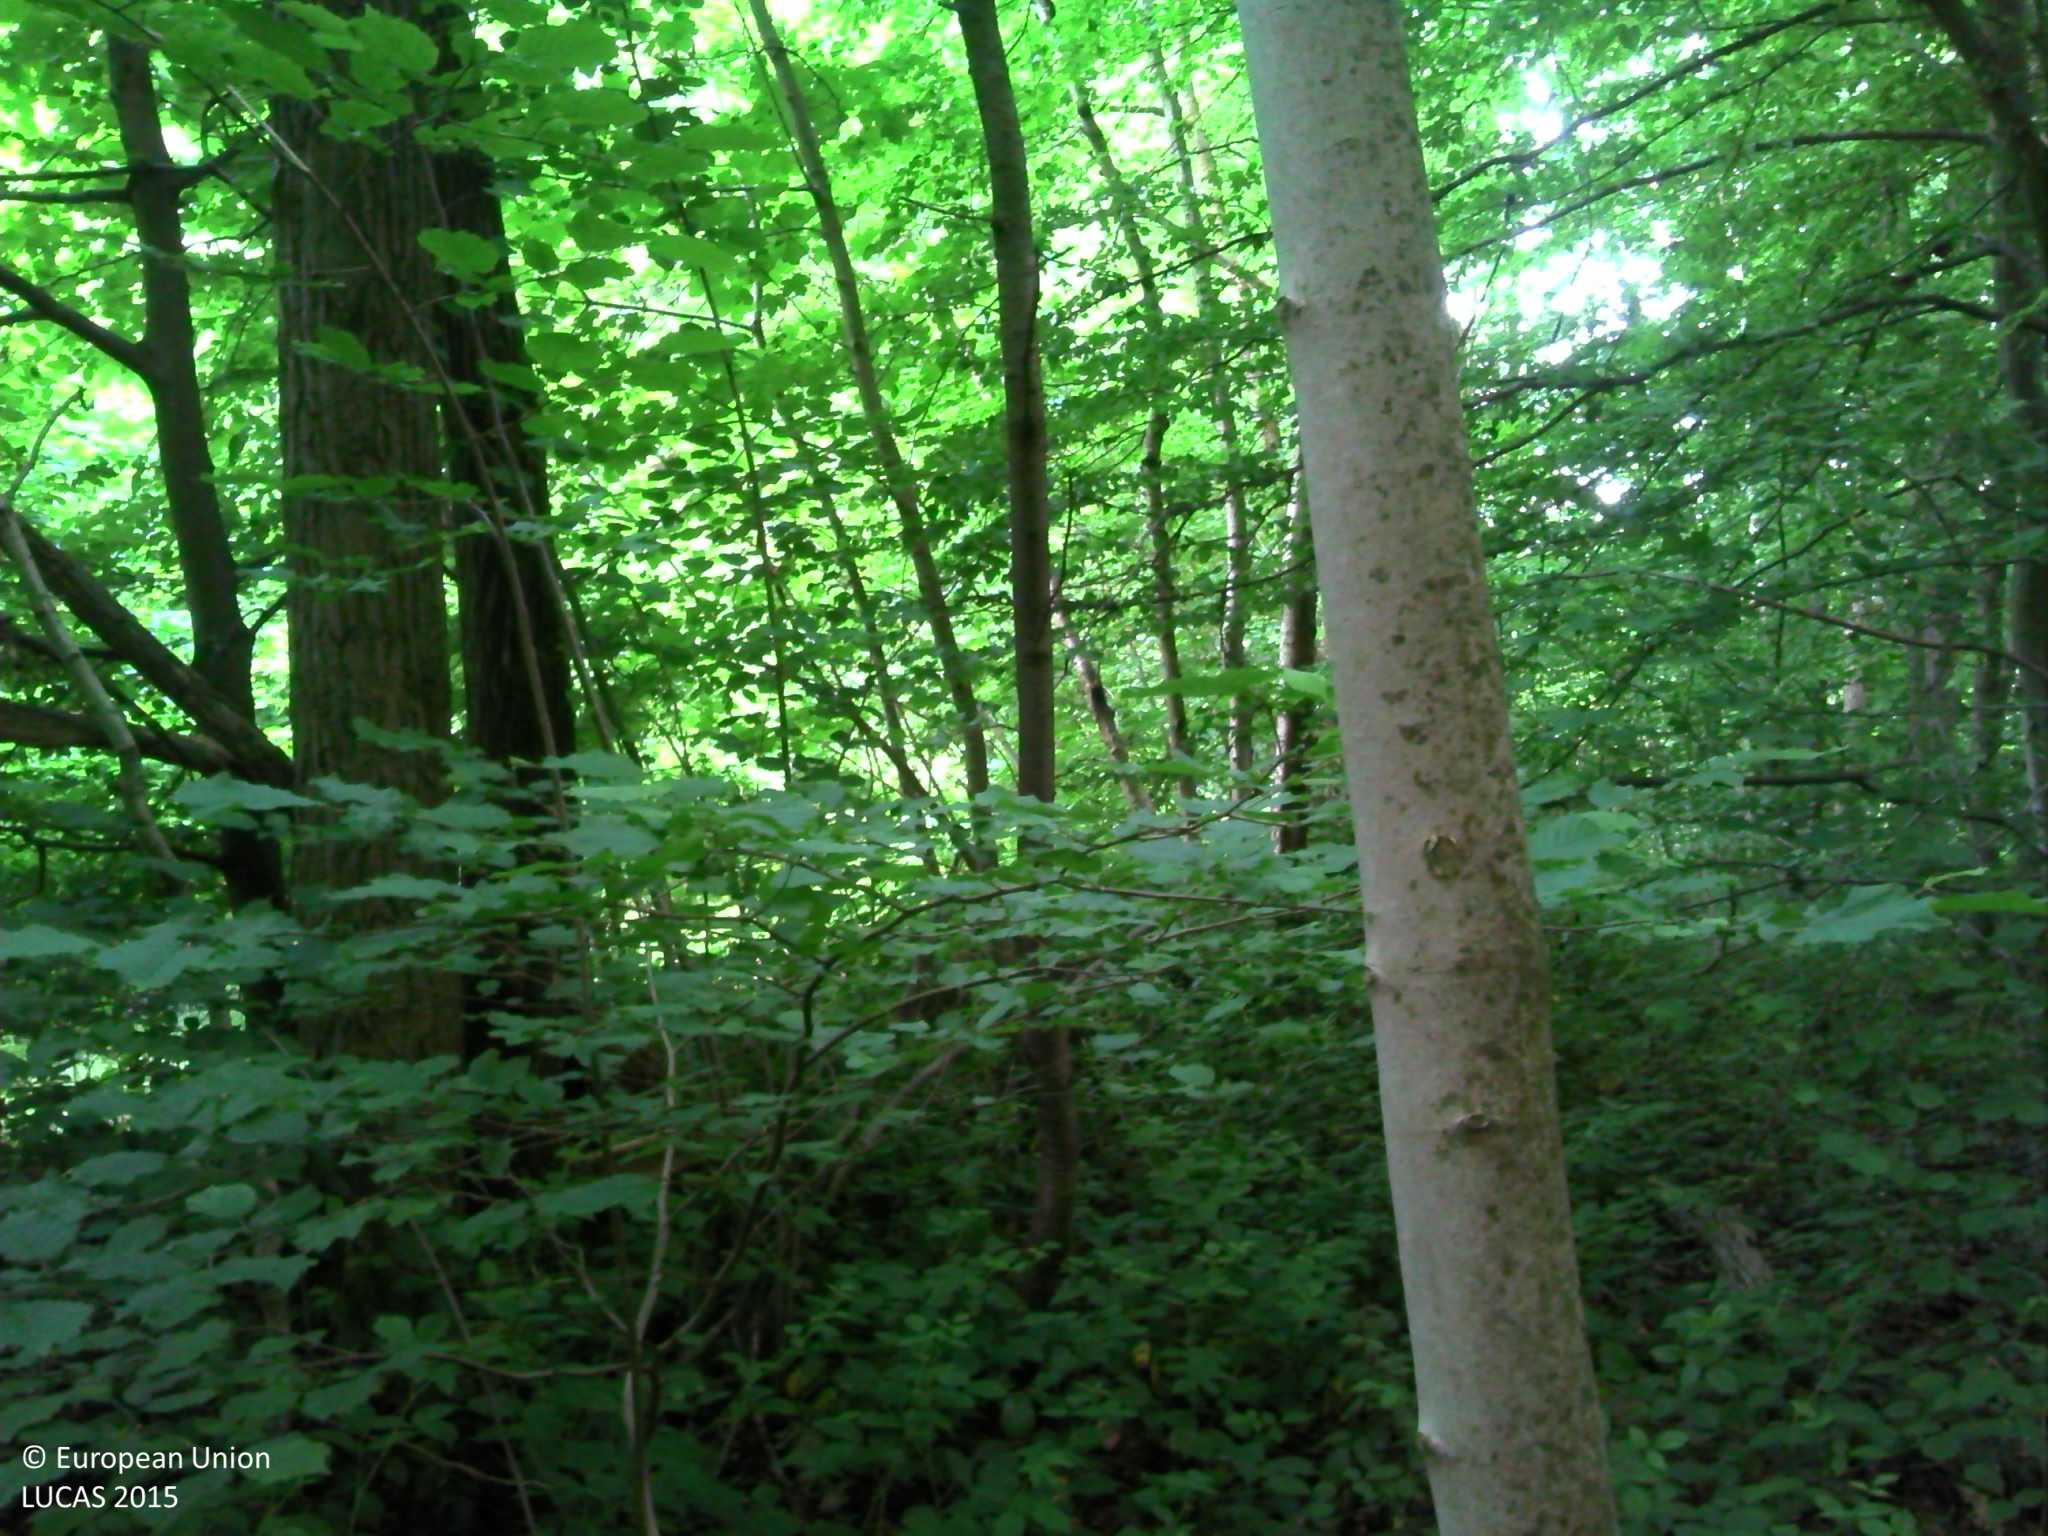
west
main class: Woodland
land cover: Broadleaved woodland
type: mesophytic deciduous forest
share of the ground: > 75 %
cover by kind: broadleaved forest trees 80 %, herbaceous plants 10 %, lichens and mosses 5 %
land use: Forestry
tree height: > 5 m
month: May
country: BE
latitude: 50.3761
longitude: 4.8926
